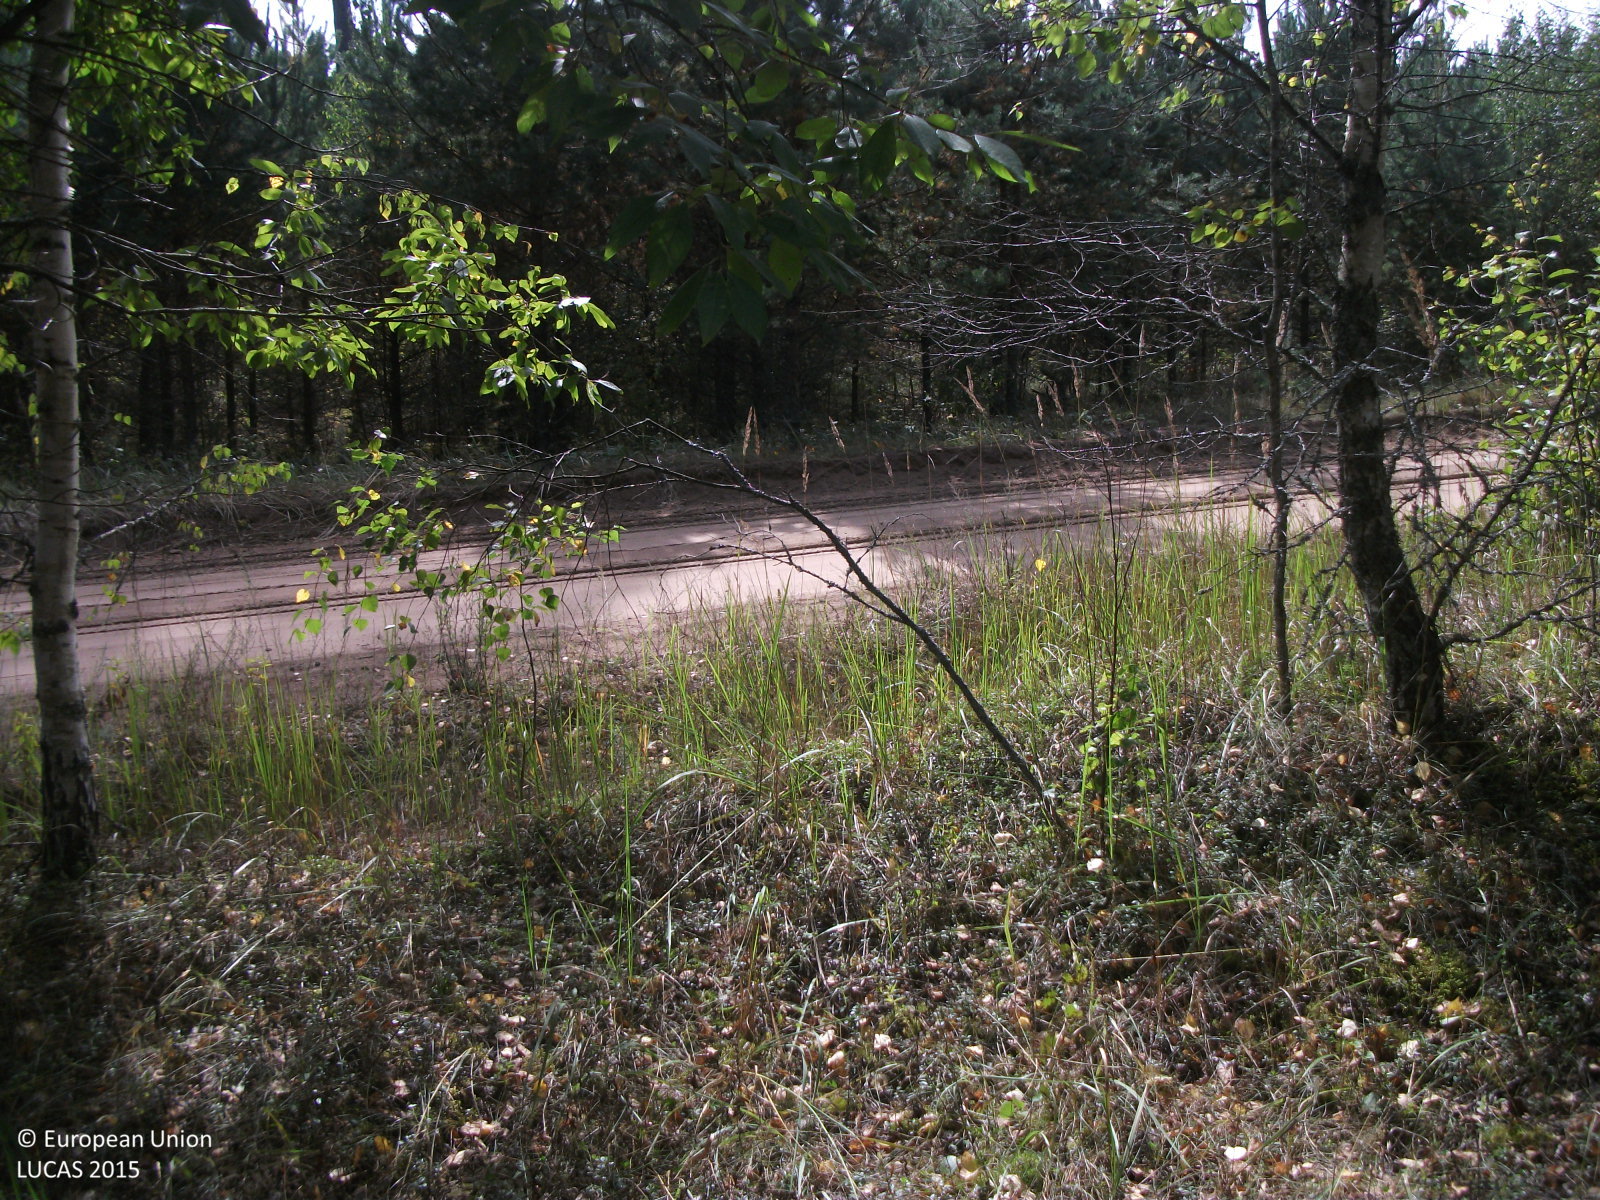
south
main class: Woodland
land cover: Pine dominated coniferous woodland
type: hemiboreal forest and nemoral coniferous forest and mixed broadleaved-coniferous forest
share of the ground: 50 - 75 %
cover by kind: coniferous forest trees 70 %, lichens and mosses 25 %, herbaceous plants 5 %
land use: Forestry
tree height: > 5 m
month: September
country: LV
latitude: 56.5760
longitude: 26.1047
